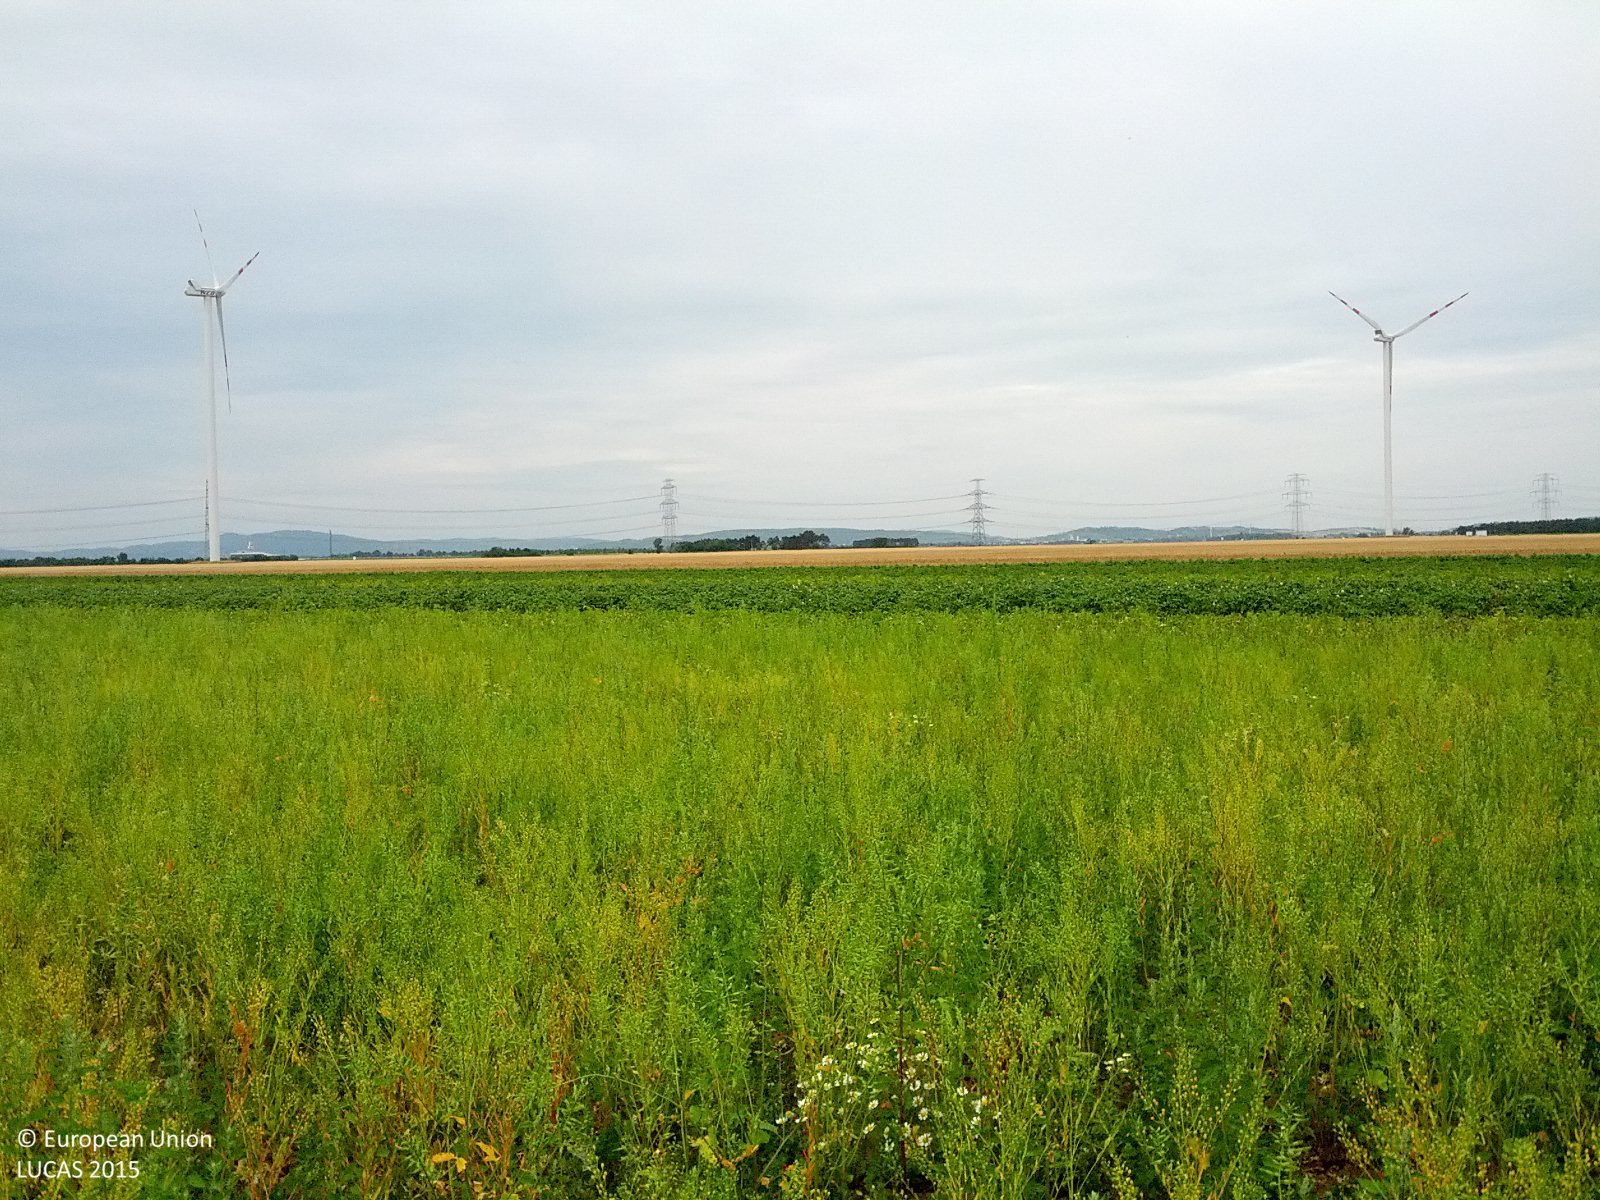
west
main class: Cropland
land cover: Clovers
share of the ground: 25 - 50 %
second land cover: Other fibre and oleaginous crops
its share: 25 - 50 %
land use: Agriculture (excluding fallow land and kitchen gardens)
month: June
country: AT
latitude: 48.3178
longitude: 16.5463
